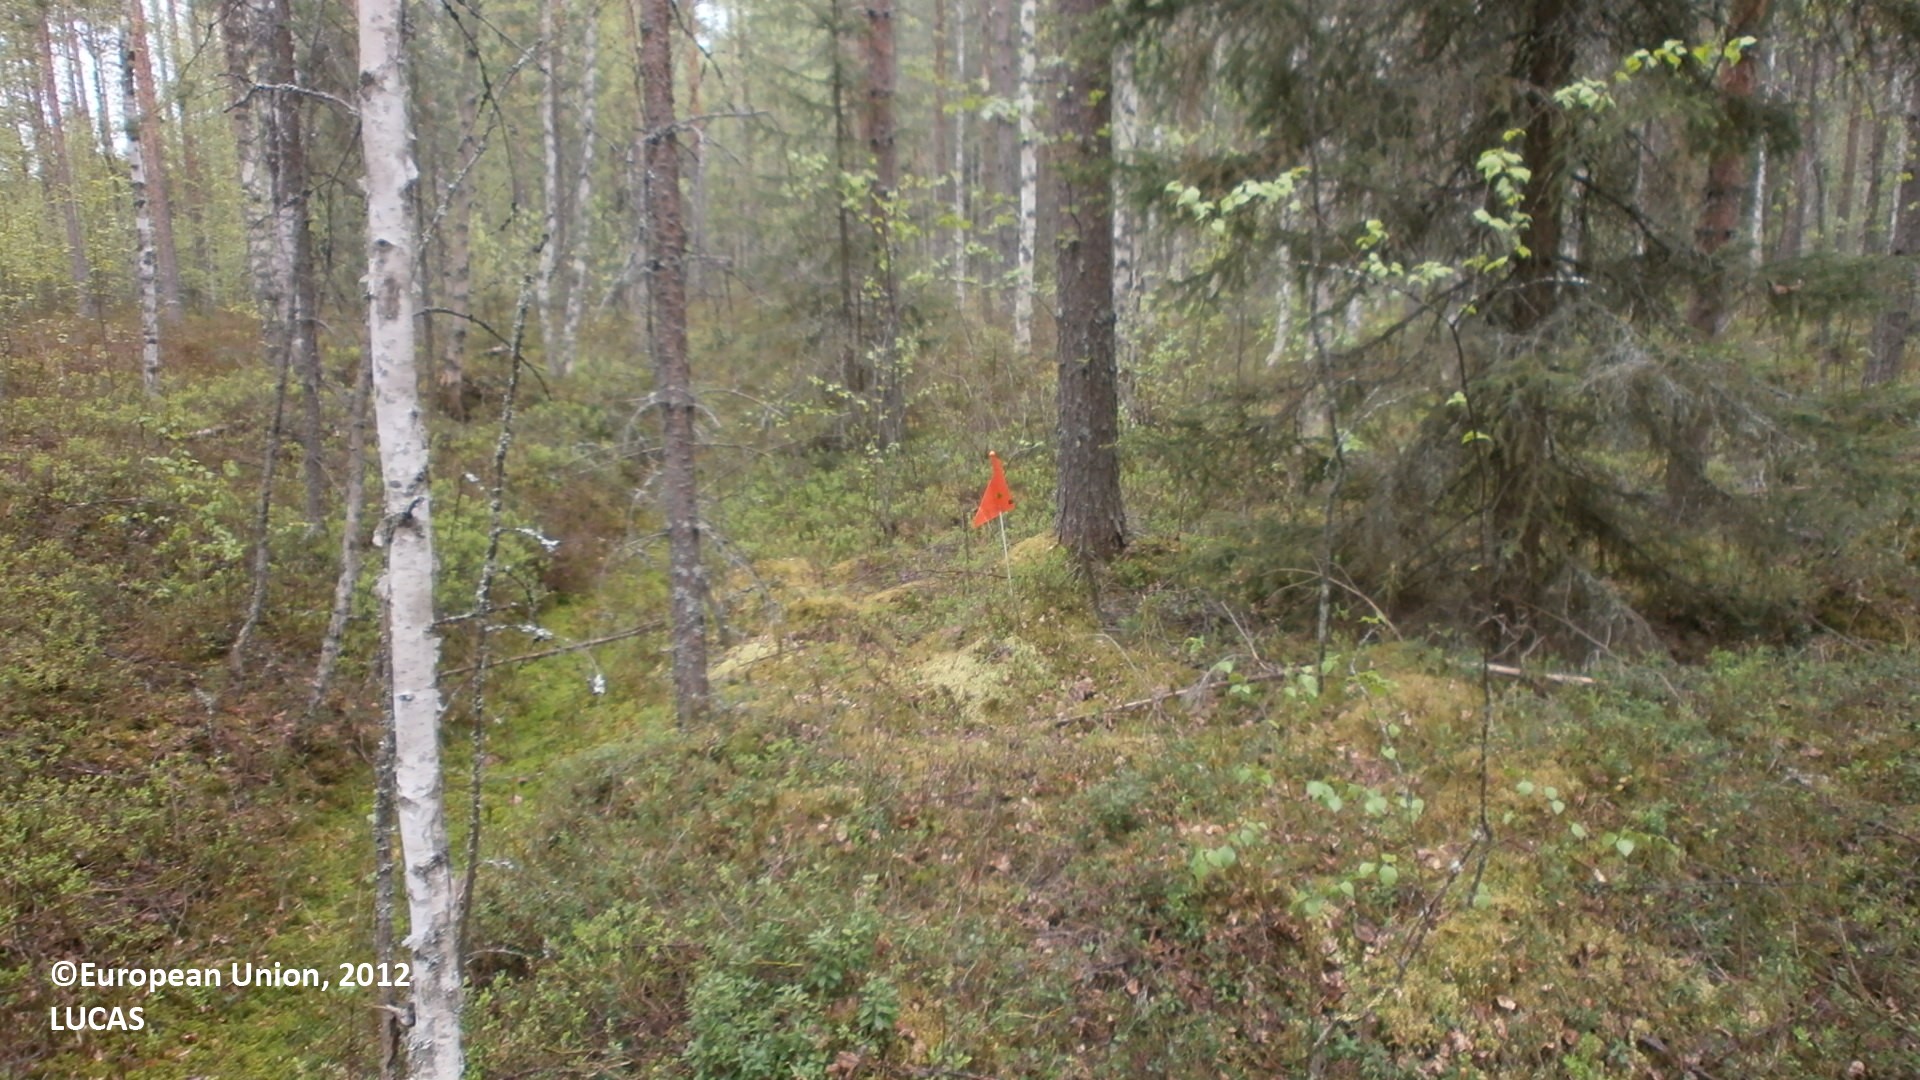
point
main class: Woodland
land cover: Pine dominated mixed woodland
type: hemiboreal forest and nemoral coniferous forest and mixed broadleaved-coniferous forest
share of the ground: 50 - 75 %
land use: Forestry
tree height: > 5 m
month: June
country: FI
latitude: 64.2953
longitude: 25.8678
